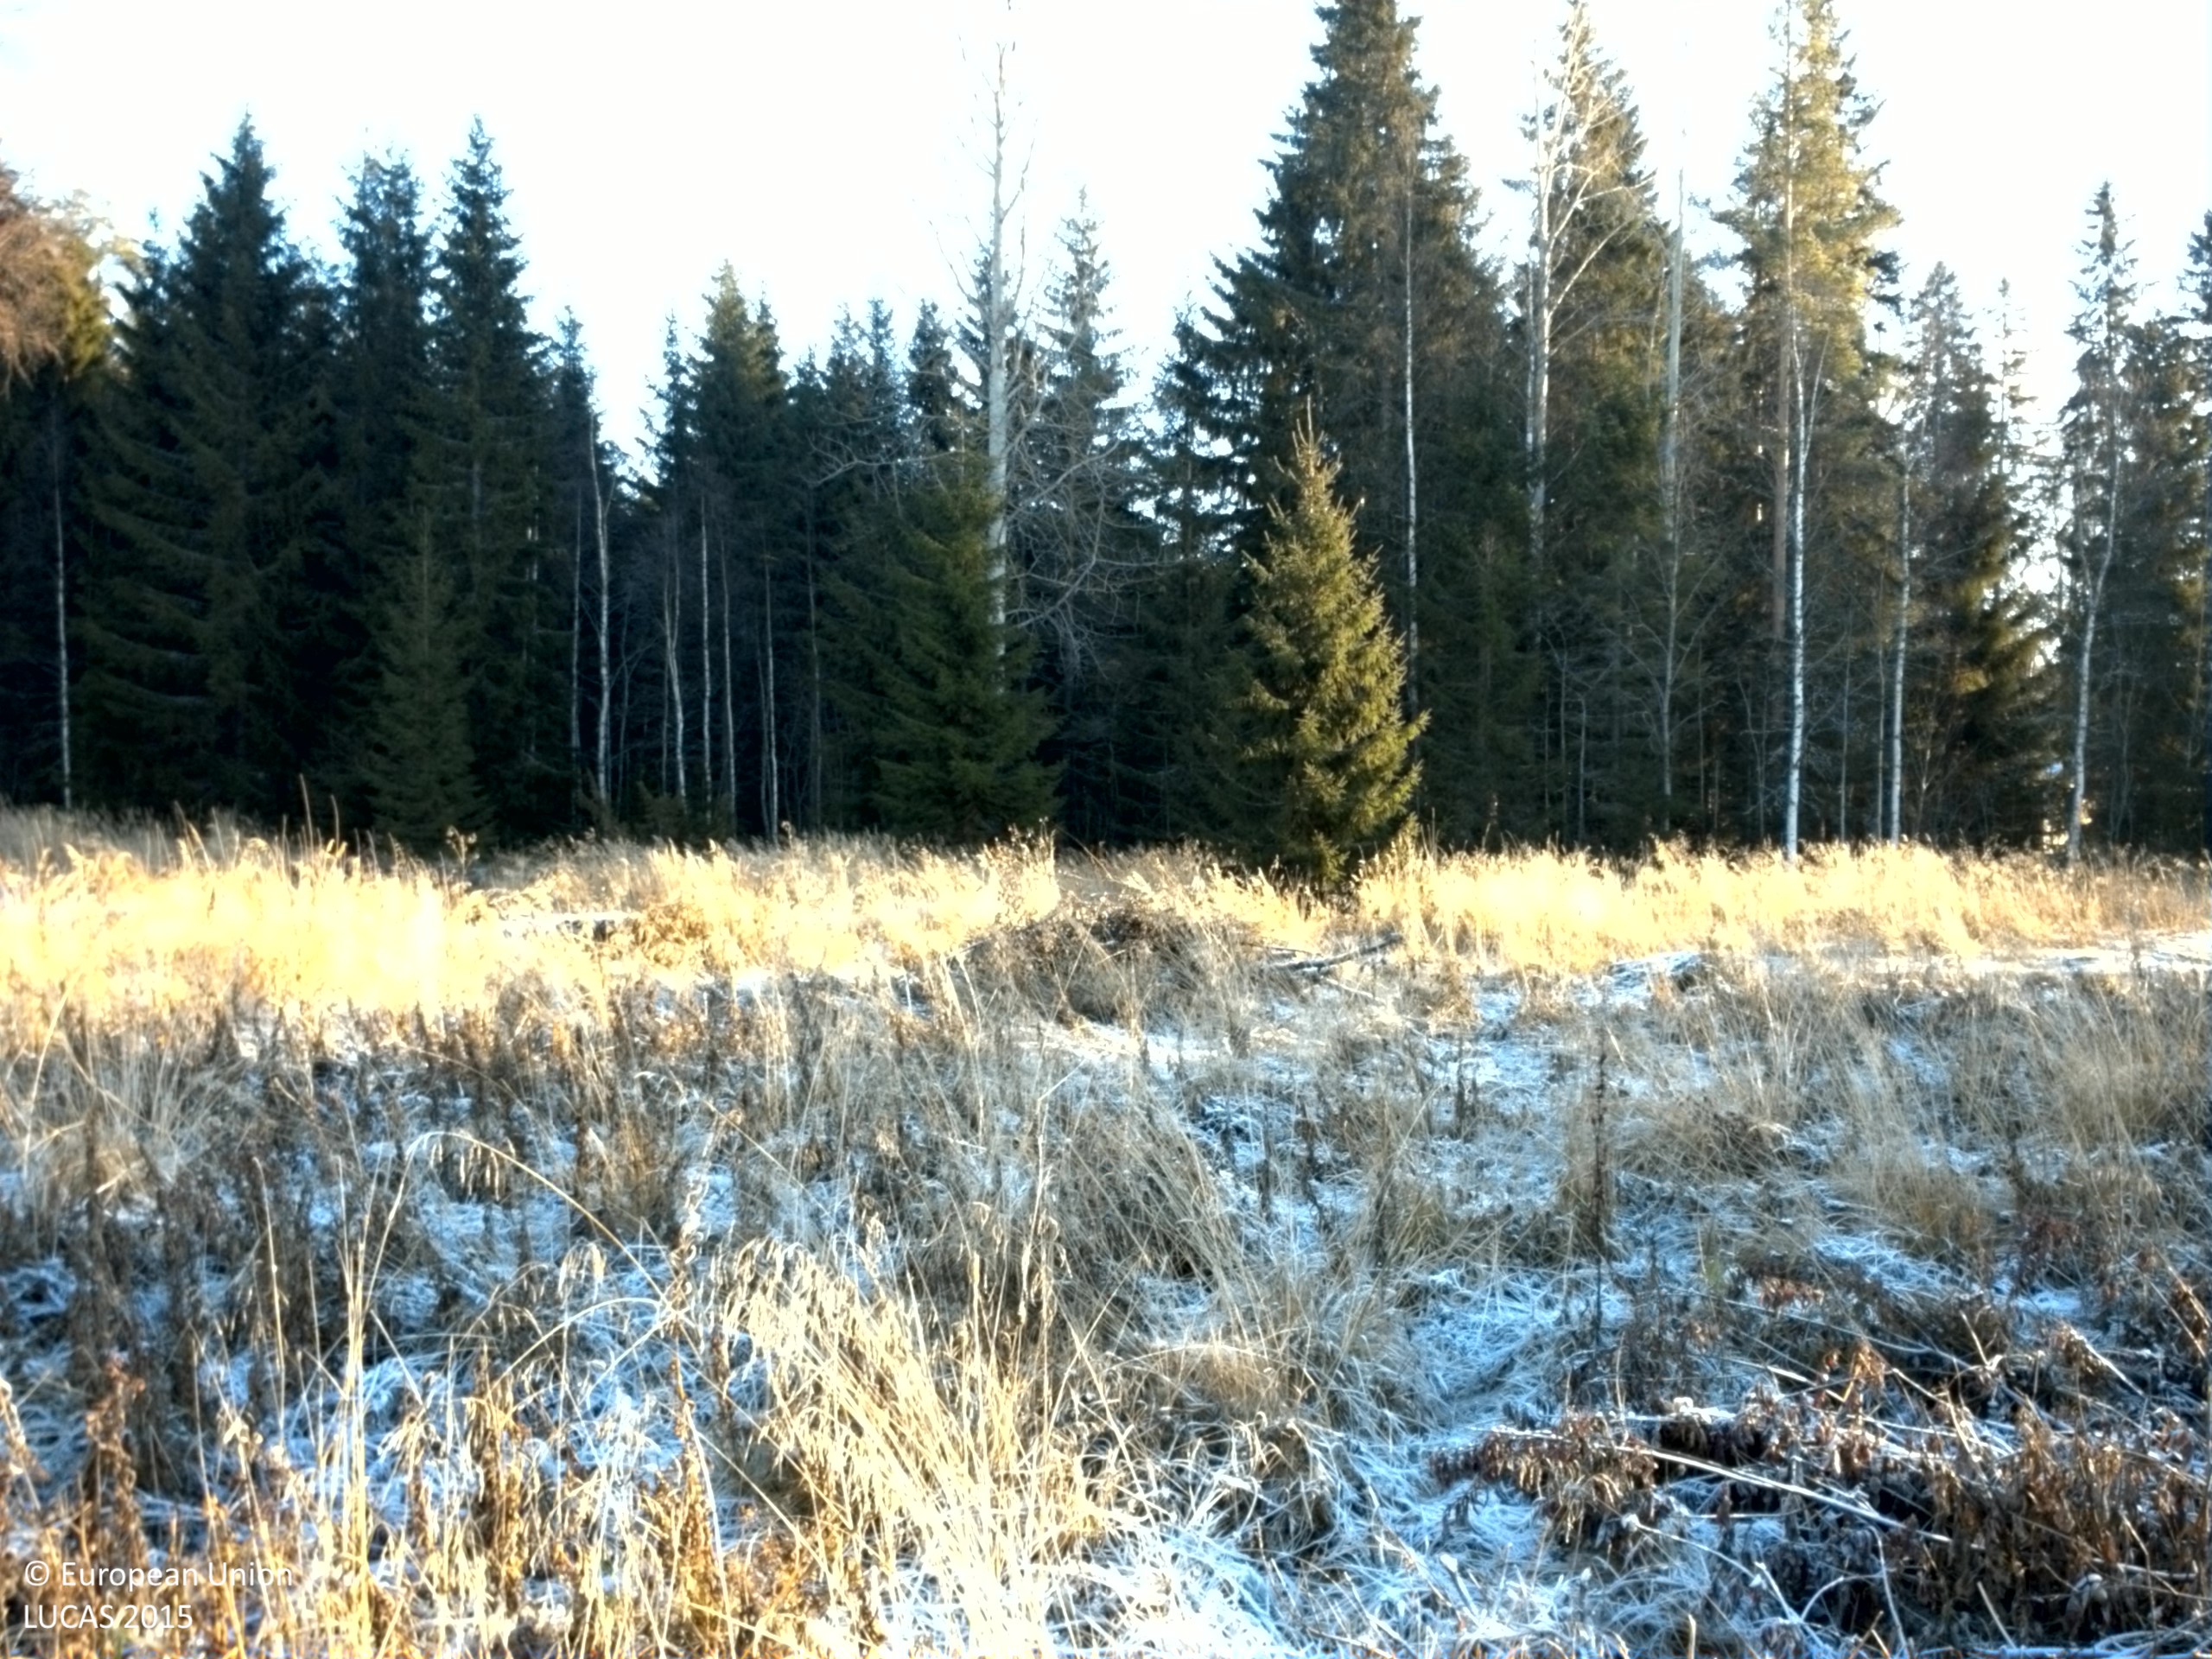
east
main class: Grassland
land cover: Grassland with sparse tree/shrub cover
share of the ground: > 75 %
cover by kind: herbaceous plants 95 %, broadleaved forest trees 5 %
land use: Amenities, museums, leisure
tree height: > 5 m
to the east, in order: Grassland with sparse tree/shrub cover; Shrubland without tree cover; Spruce dominated mixed woodland; Tracks; Spruce dominated mixed woodland; Rivers and streams; Spruce dominated mixed woodland; Rivers and streams; Spruce dominated mixed woodland; Ditches and canals; Spruce dominated mixed woodland; Rivers and streams; Spruce dominated mixed woodland; Rocks and stones; Shruby margins; Ditches and canals; Paved roads, cycling and walking lanes; Ditches and canals; Grassland without tree/shrub cover
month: November
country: SE
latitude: 61.8650
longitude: 16.3125
